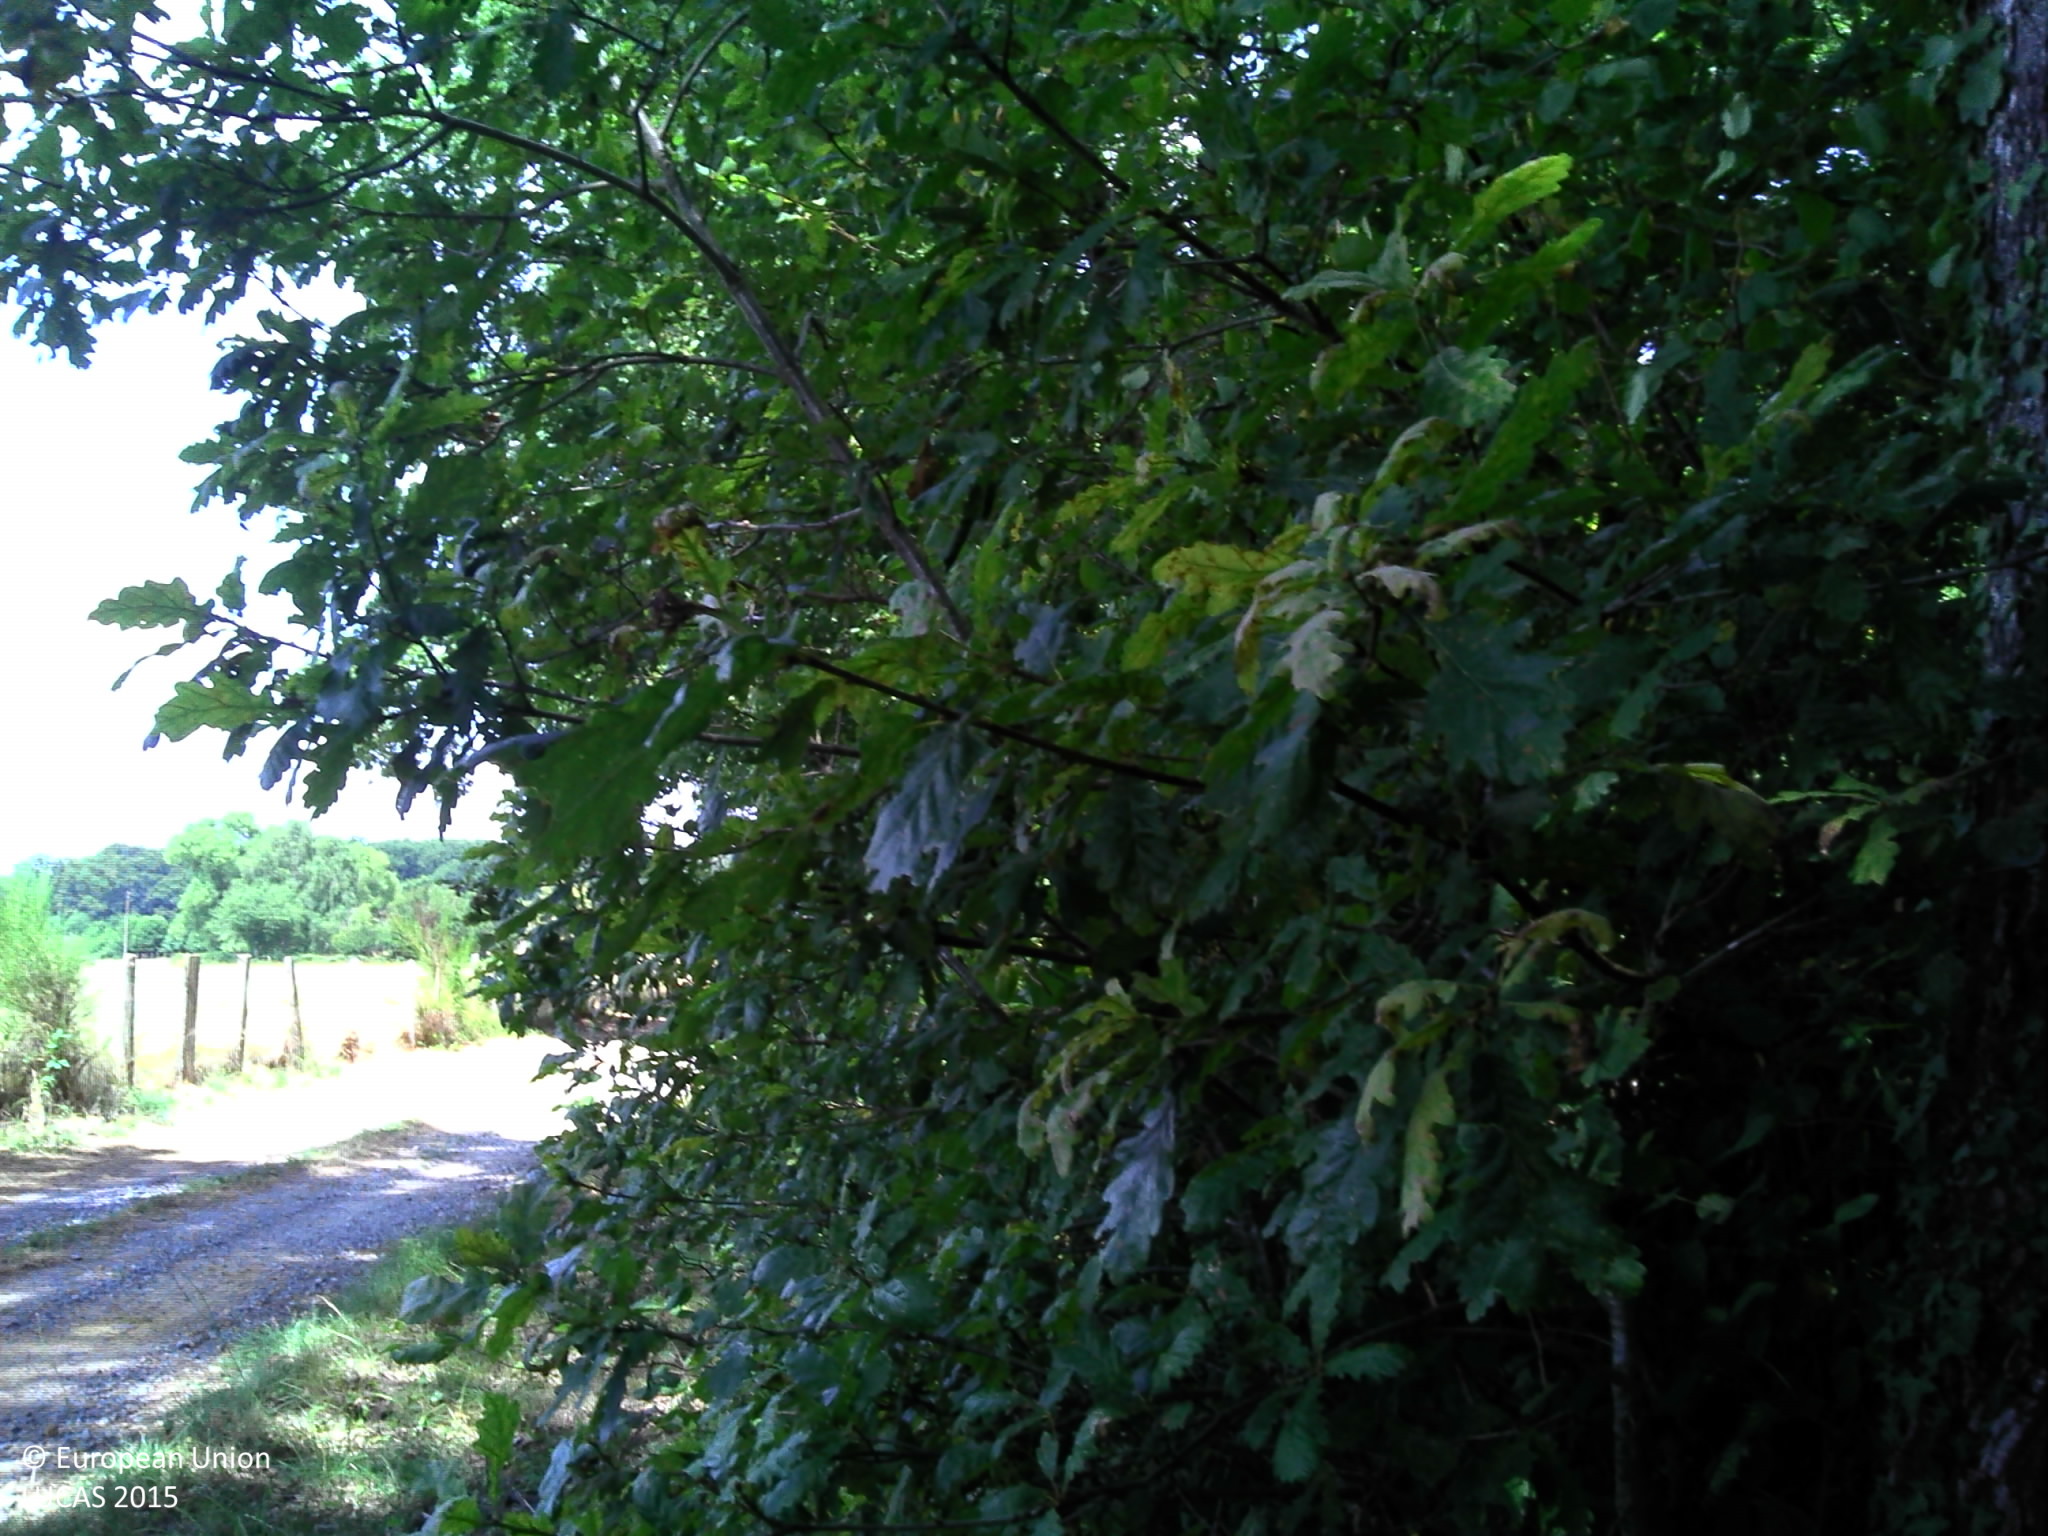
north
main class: Woodland
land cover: Broadleaved woodland
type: acidophilous oak and oak-birch forest
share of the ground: > 75 %
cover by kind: broadleaved forest trees 50 %, shrubs 30 %, herbaceous plants 20 %
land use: Forestry
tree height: > 5 m
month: July
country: FR
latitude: 48.0542
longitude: 0.5721
